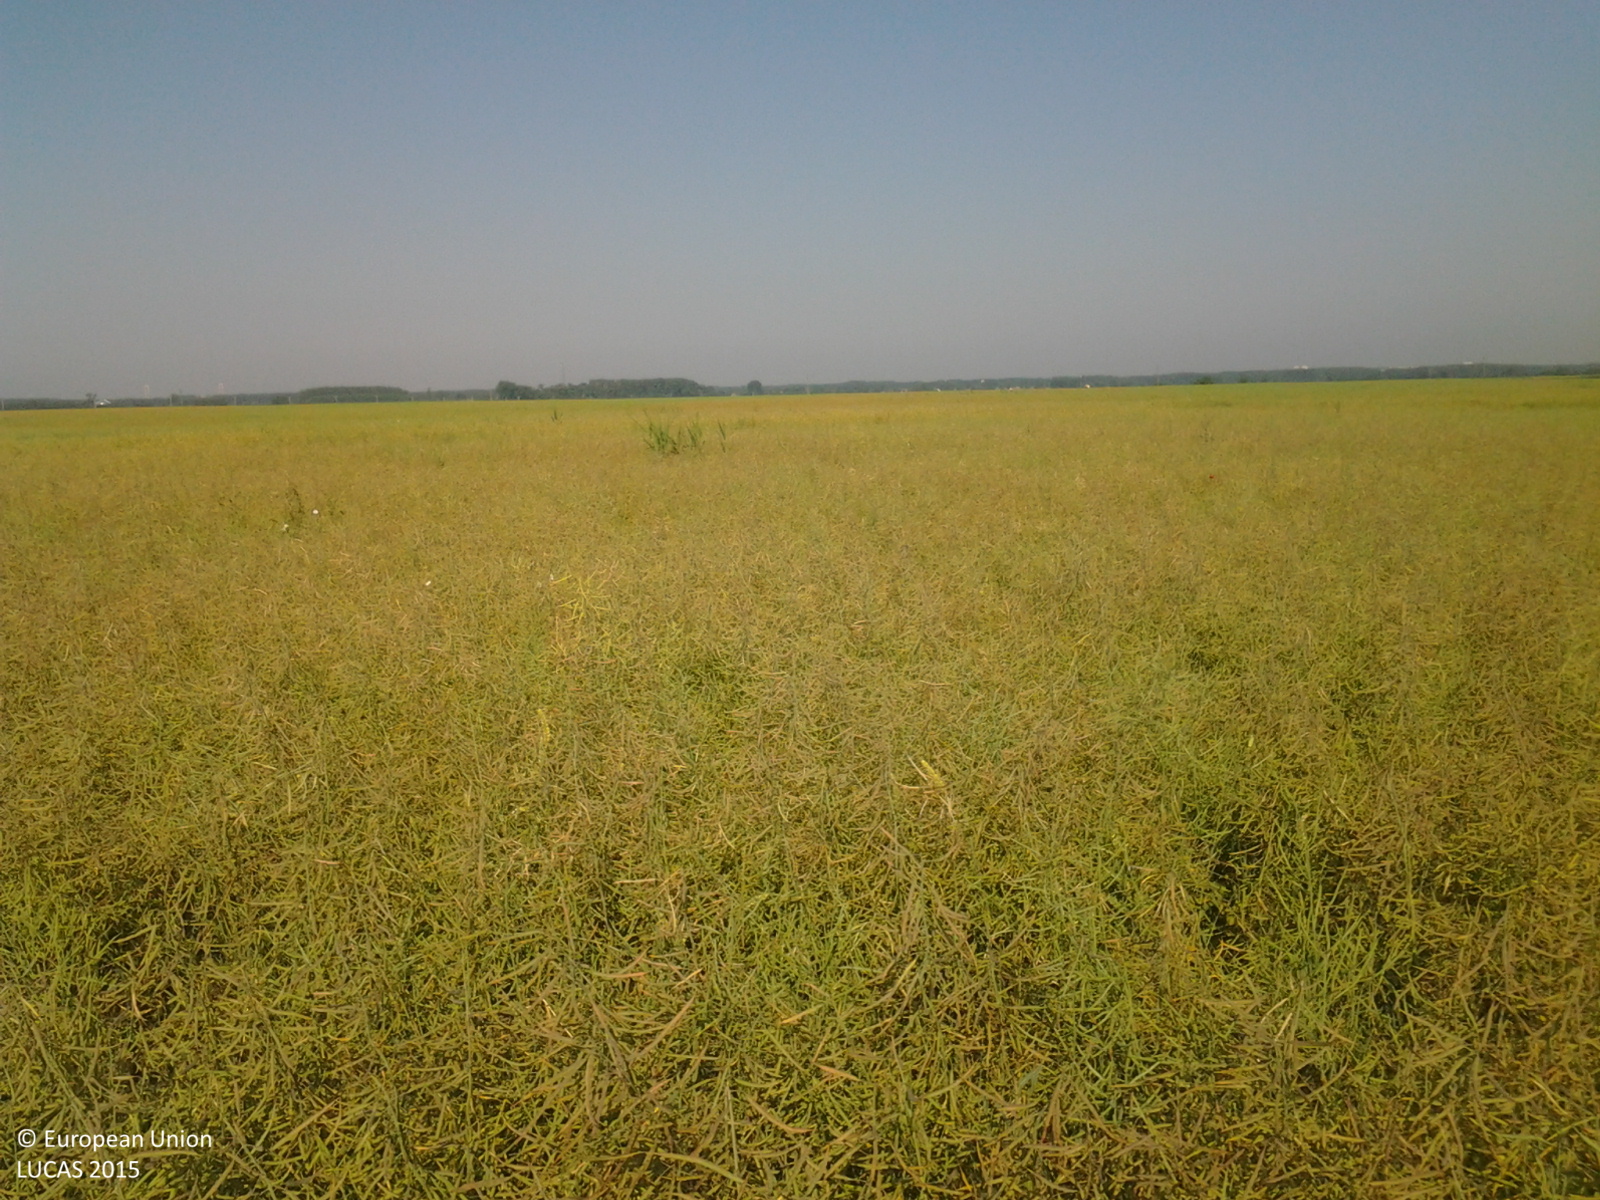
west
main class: Cropland
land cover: Rape and turnip rape
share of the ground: > 75 %
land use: Agriculture (excluding fallow land and kitchen gardens)
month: June
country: HU
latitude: 46.5931
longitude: 18.9284
